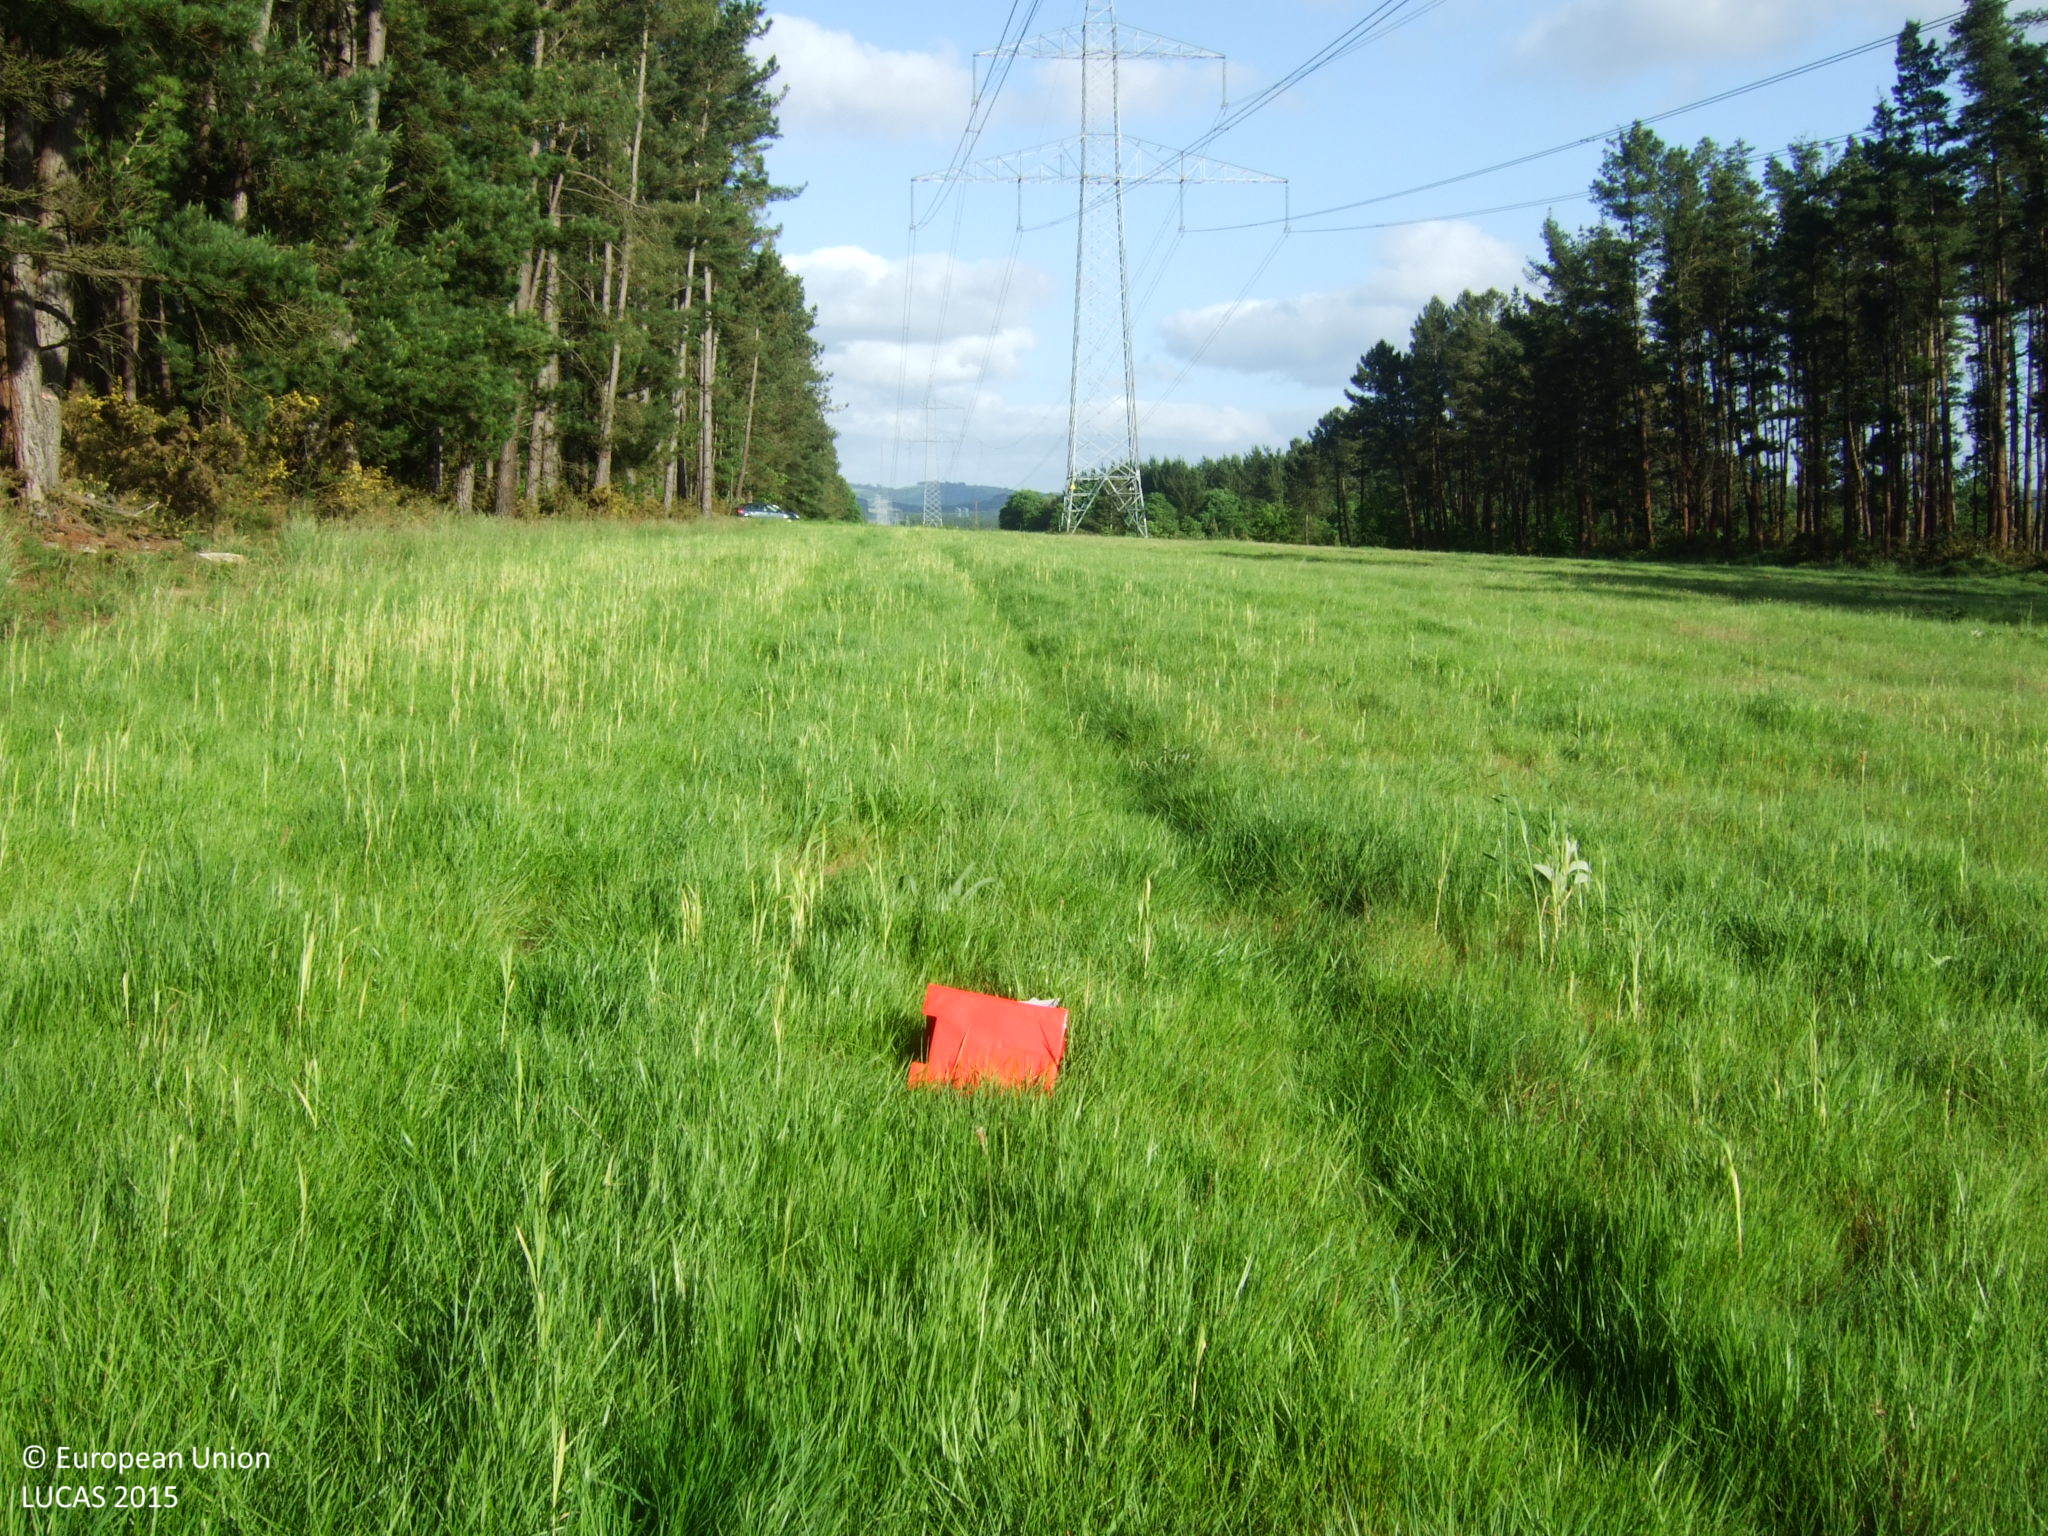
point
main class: Artificial land
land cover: Other artificial areas
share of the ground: < 10 %
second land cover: Grassland without tree/shrub cover
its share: > 75 %
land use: Electricity, gas and thermal power distribution
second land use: Agriculture (excluding fallow land and kitchen gardens)
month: May
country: ES
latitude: 43.1523
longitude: -7.4519
